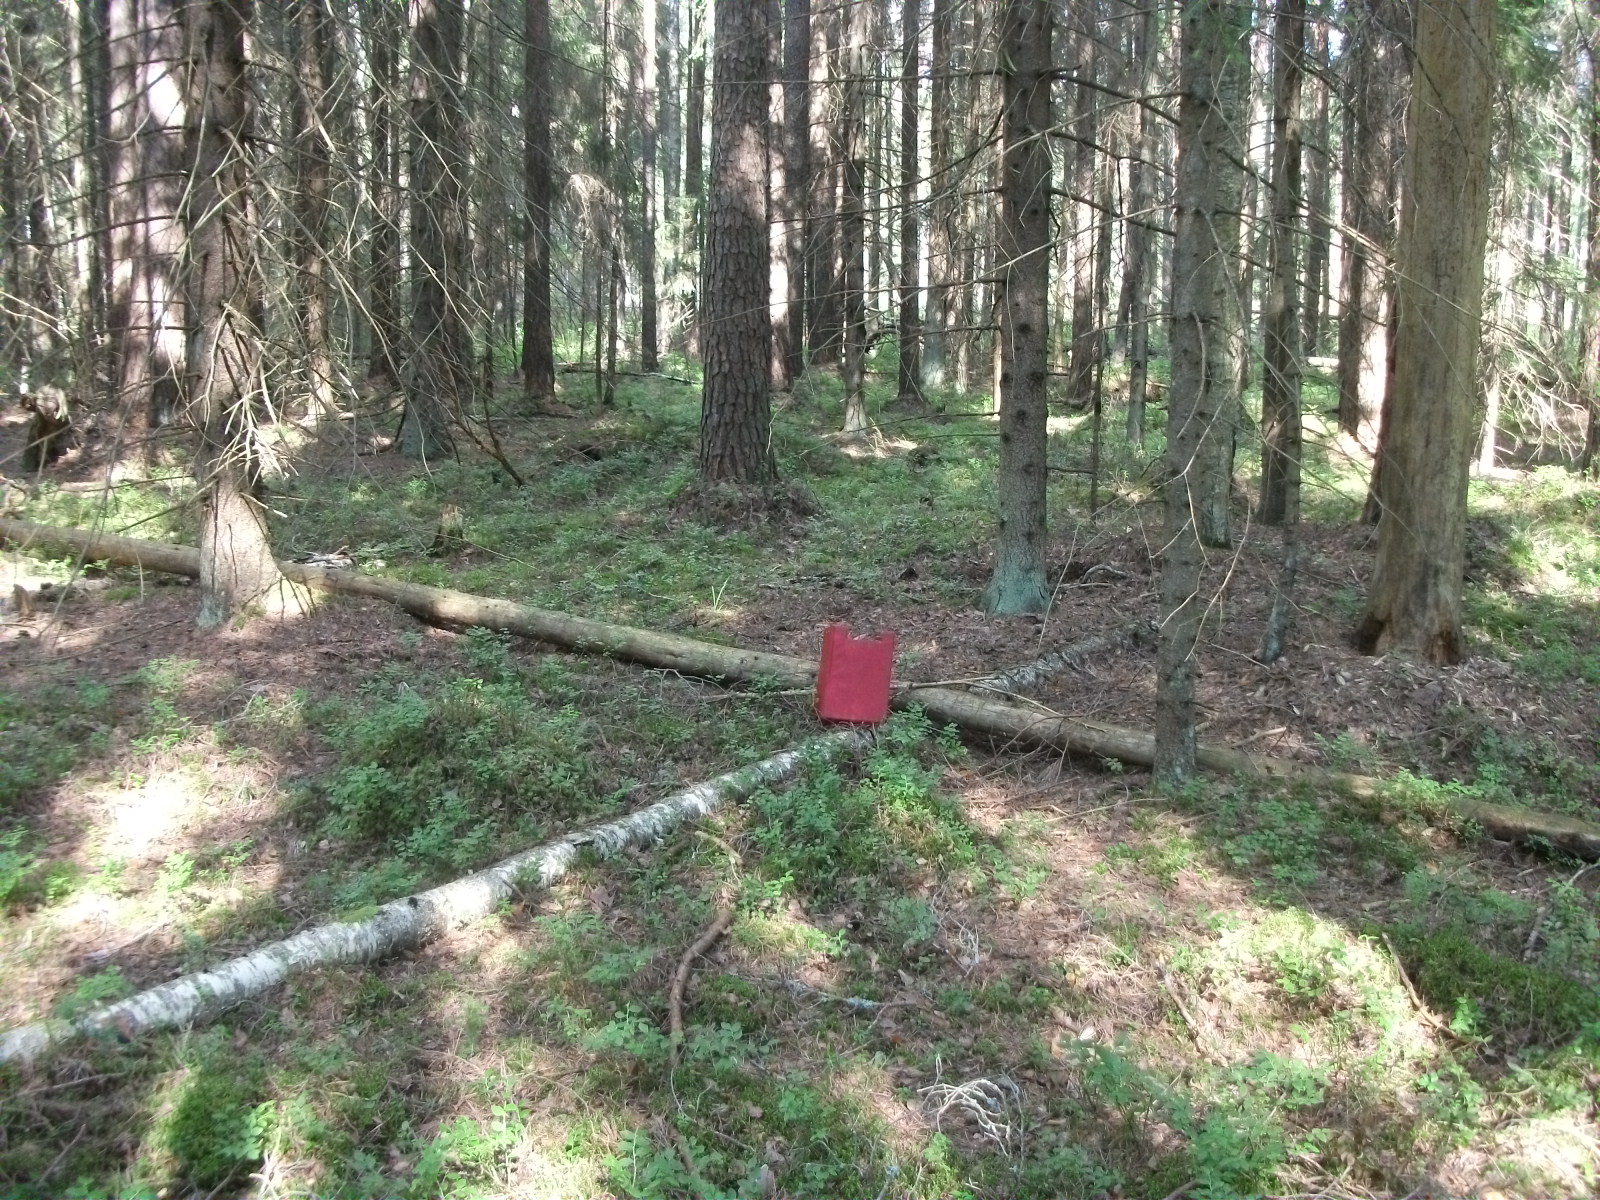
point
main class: Woodland
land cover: Other coniferous woodland
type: hemiboreal forest and nemoral coniferous forest and mixed broadleaved-coniferous forest
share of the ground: > 75 %
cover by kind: coniferous forest trees 80 %, shrubs 5 %, herbaceous plants 5 %, lichens and mosses 5 %, unconsolidated bare surface 5 %
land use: Forestry
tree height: > 5 m
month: August
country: LV
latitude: 56.8010
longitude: 26.5055
